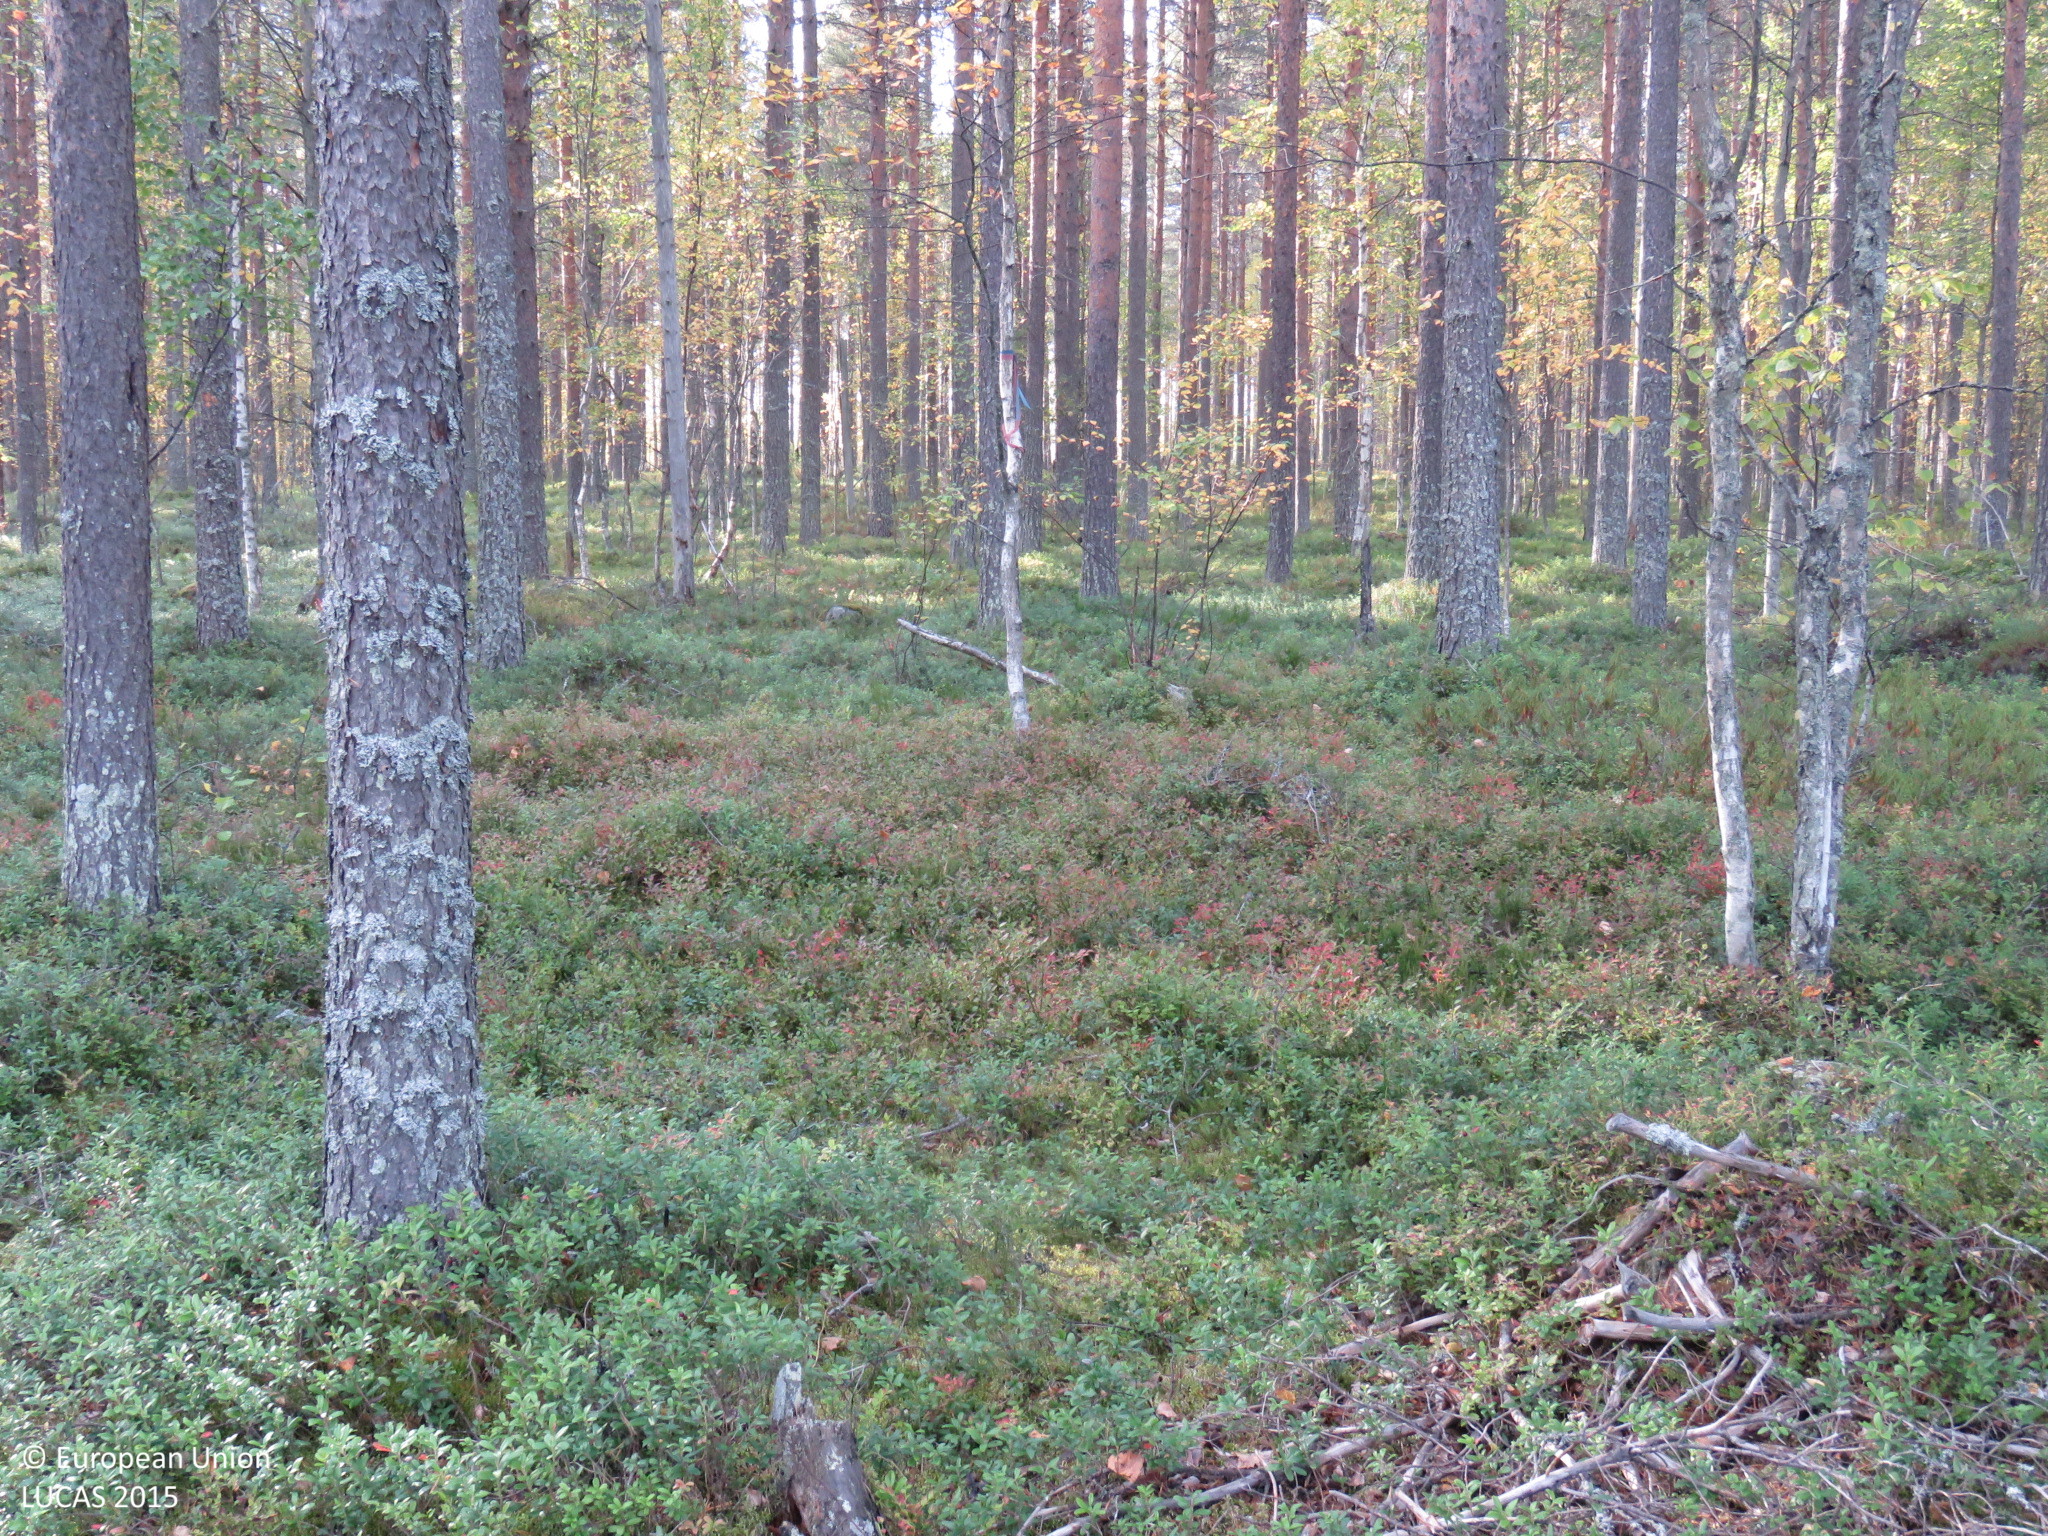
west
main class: Woodland
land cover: Pine dominated coniferous woodland
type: boreal forest
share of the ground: > 75 %
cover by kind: coniferous forest trees 60 %, shrubs 20 %, broadleaved forest trees 15 %, lichens and mosses 5 %
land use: Forestry
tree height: > 5 m
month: September
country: FI
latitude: 65.0440
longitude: 26.7026
